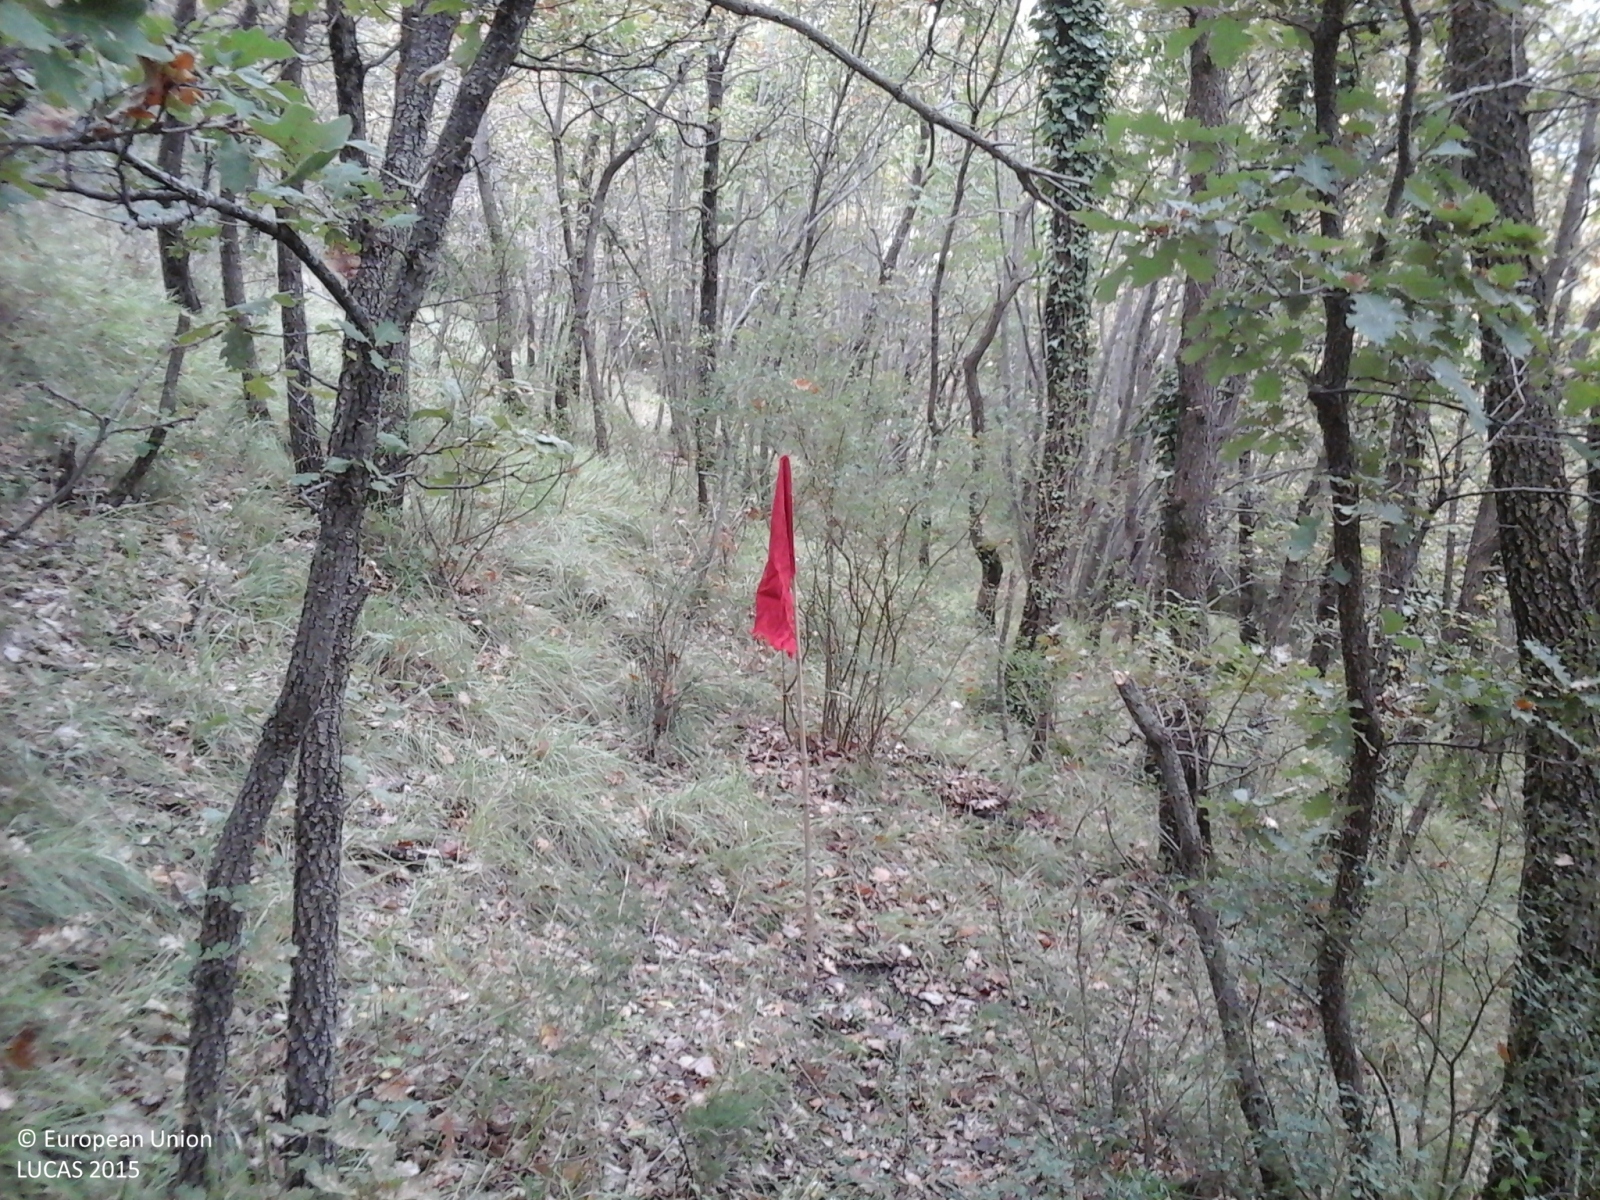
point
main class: Woodland
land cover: Broadleaved woodland
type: thermophilous deciduous forest
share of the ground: > 75 %
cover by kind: broadleaved forest trees 100 %
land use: Forestry
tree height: > 5 m
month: September
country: IT
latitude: 43.4270
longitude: 12.8460
